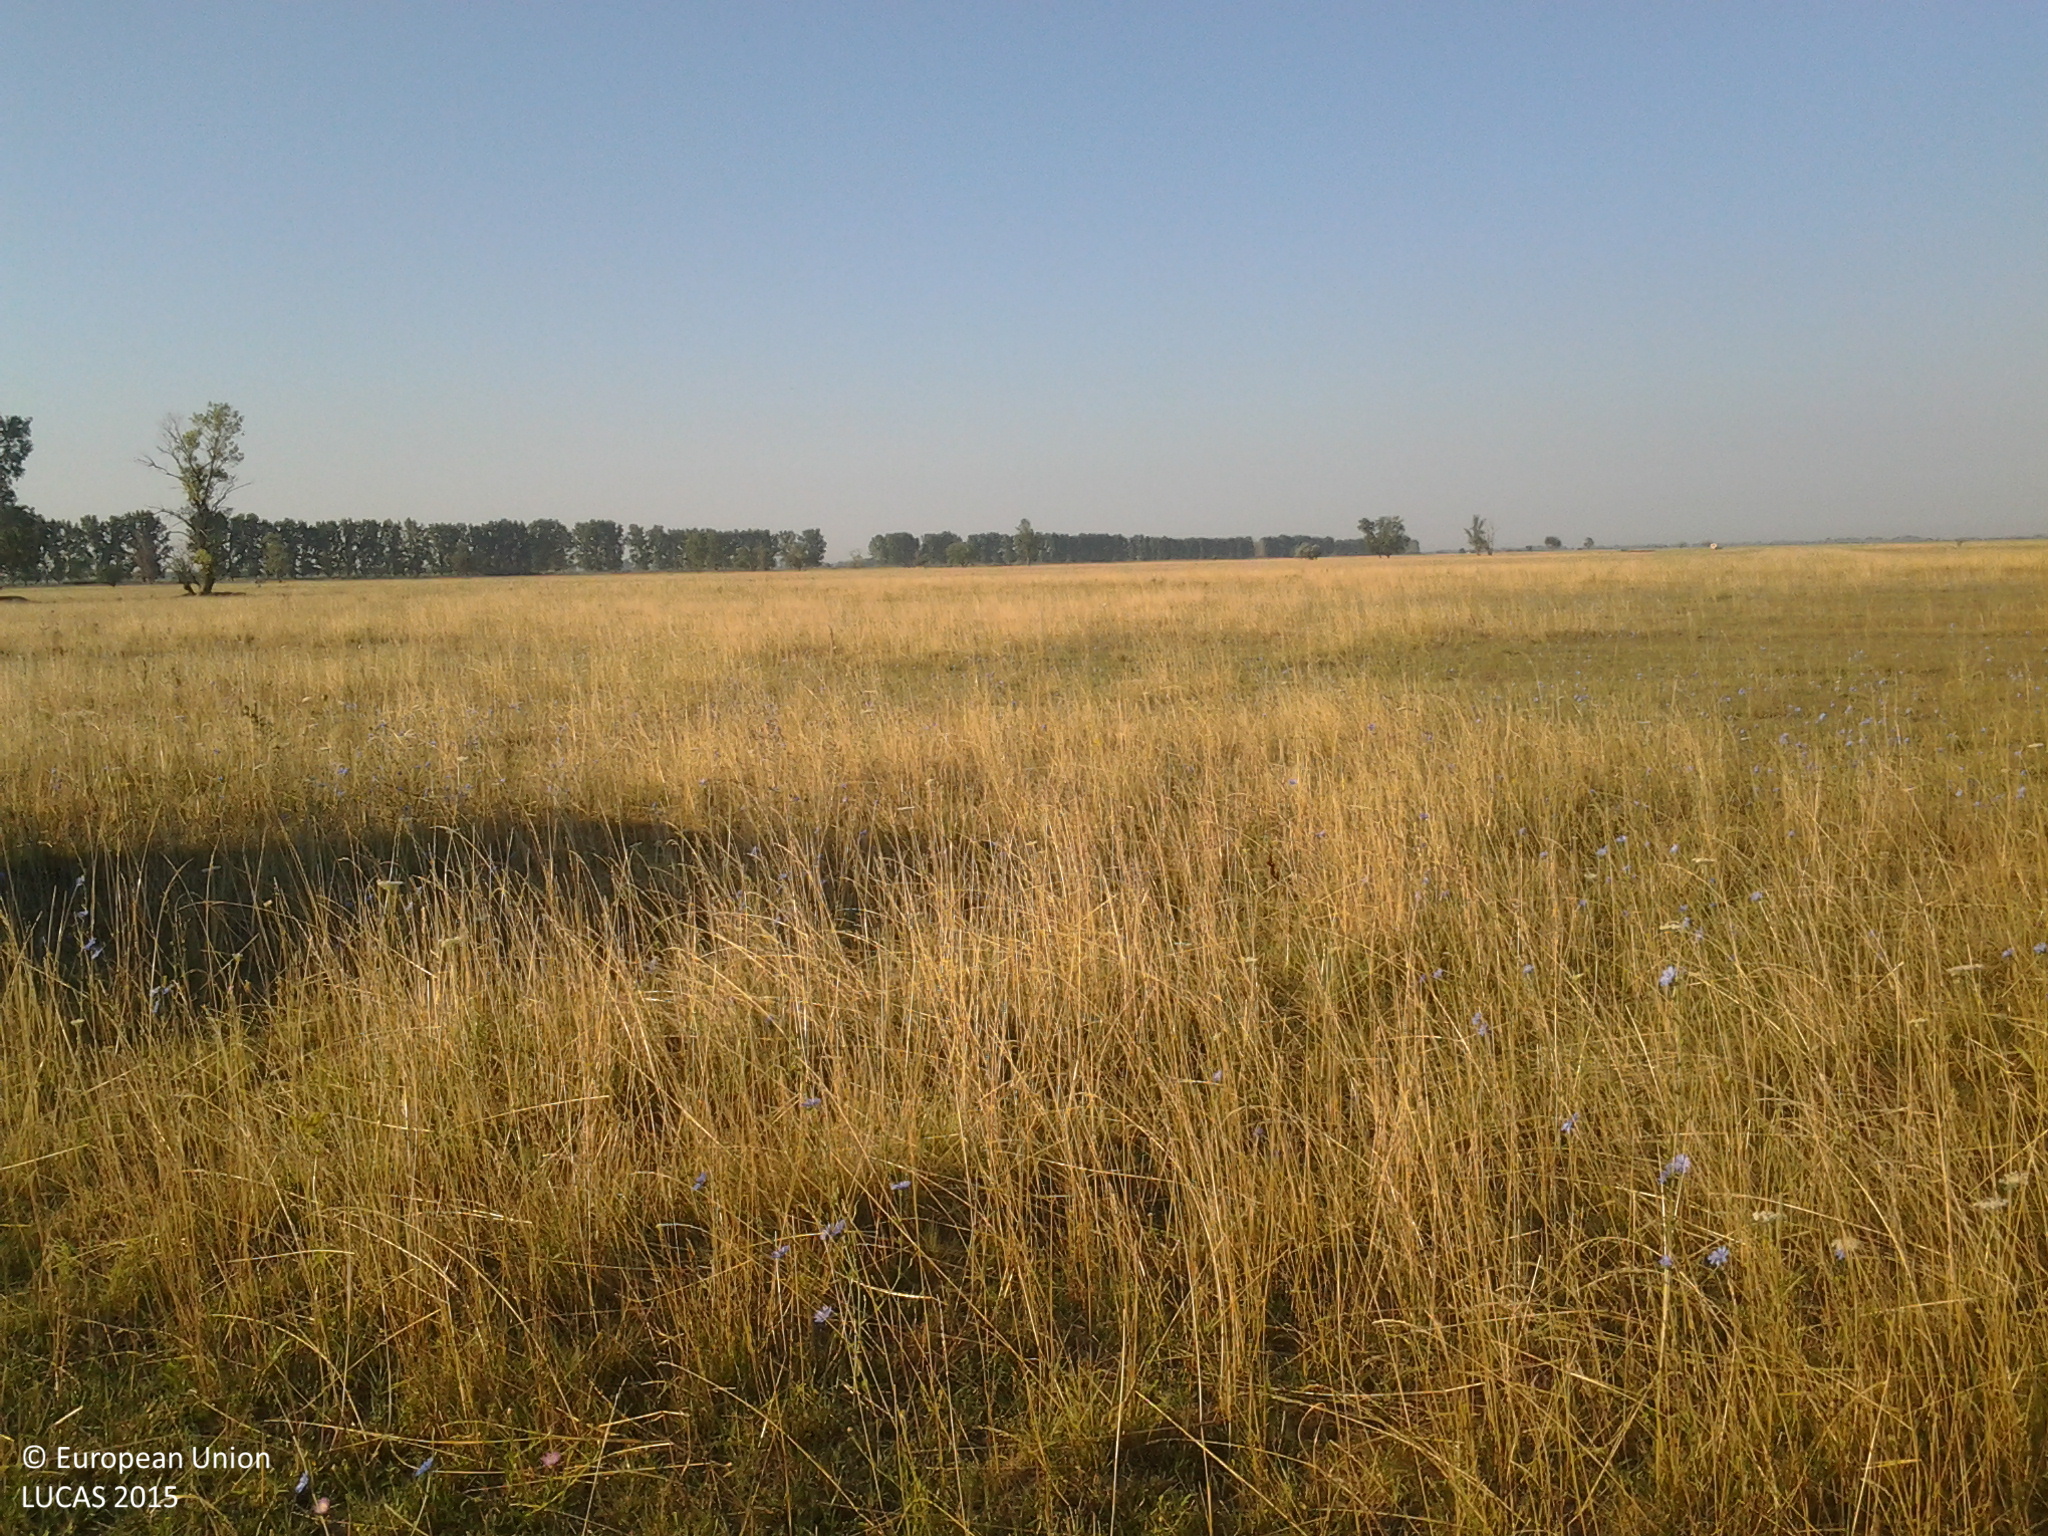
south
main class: Grassland
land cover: Grassland without tree/shrub cover
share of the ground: > 75 %
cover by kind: herbaceous plants 100 %
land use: Agriculture (excluding fallow land and kitchen gardens)
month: July
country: HU
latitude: 46.7676
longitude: 19.2218
